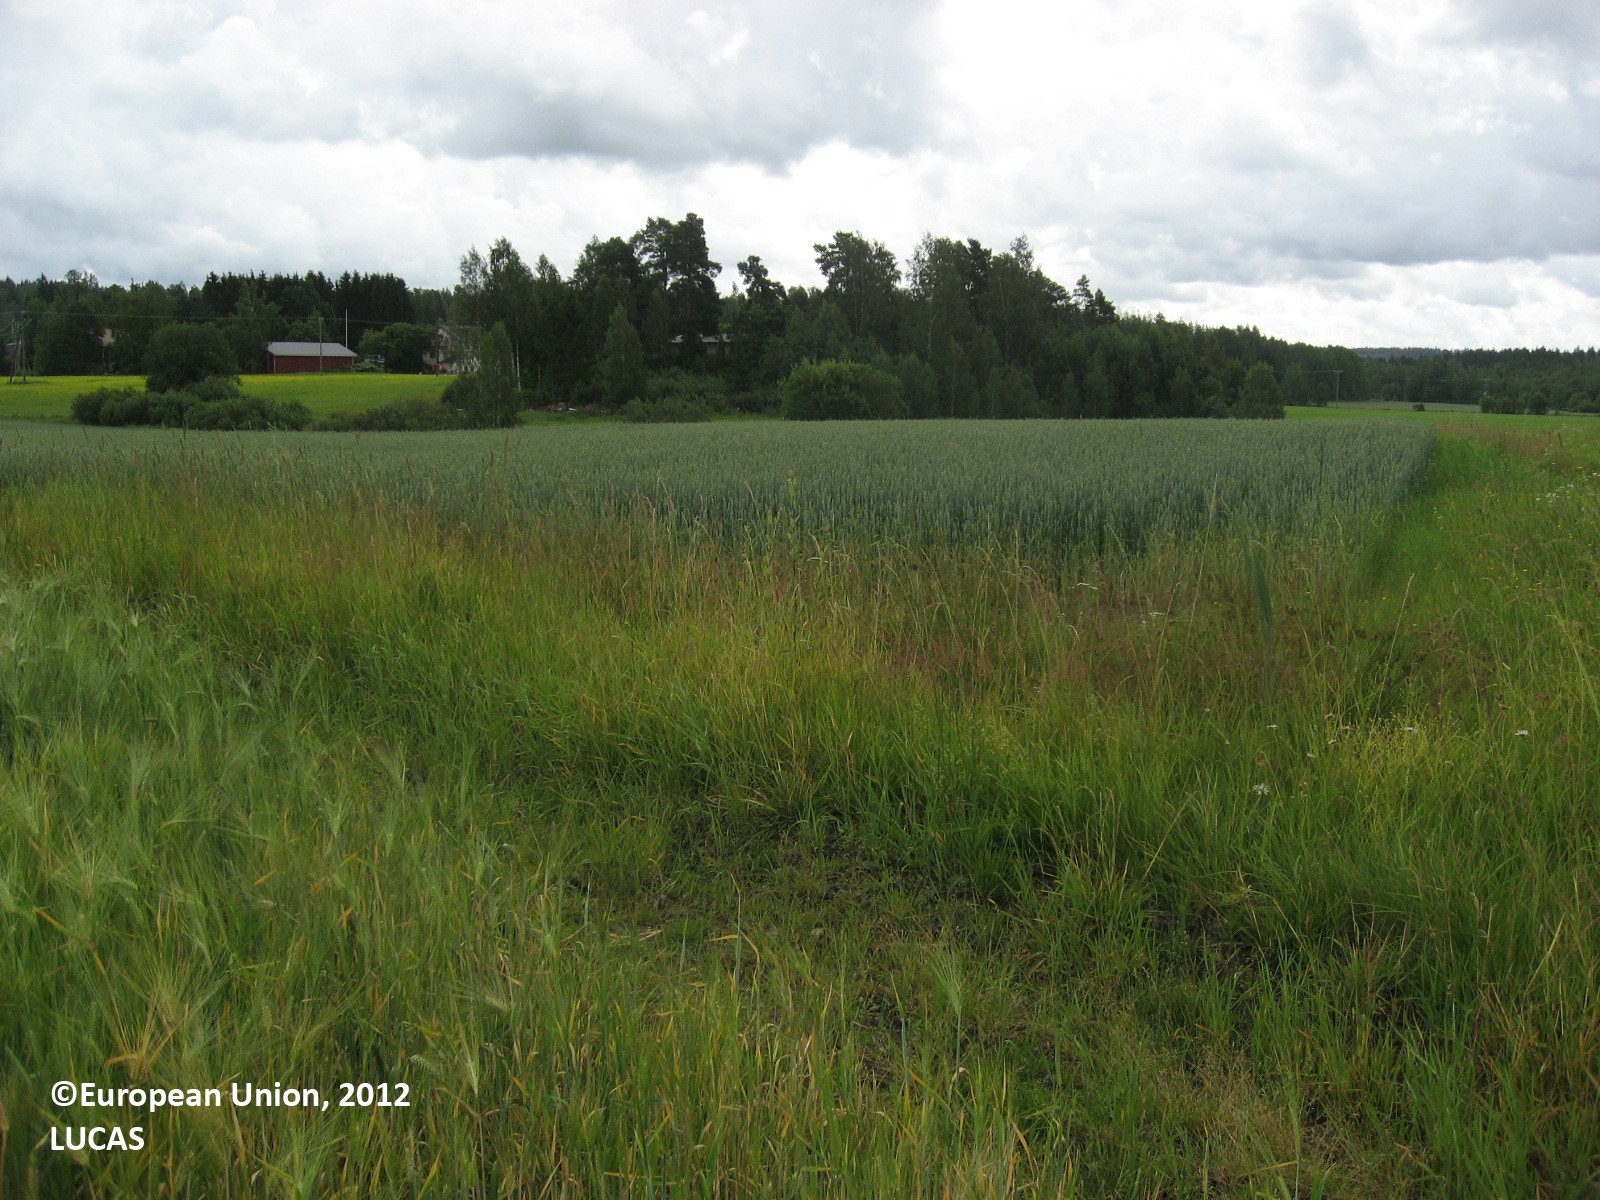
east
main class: Cropland
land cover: Barley
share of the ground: > 75 %
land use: Agriculture (excluding fallow land and kitchen gardens)
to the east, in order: Barley; Grass margins; Spruce dominated mixed woodland; Grass margins; Common wheat; Broadleaved woodland; Rivers and streams; Broadleaved woodland; Grass margins; Rape and turnip rape; Electric lines; Rape and turnip rape
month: July
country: FI
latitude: 61.0682
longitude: 25.6384
